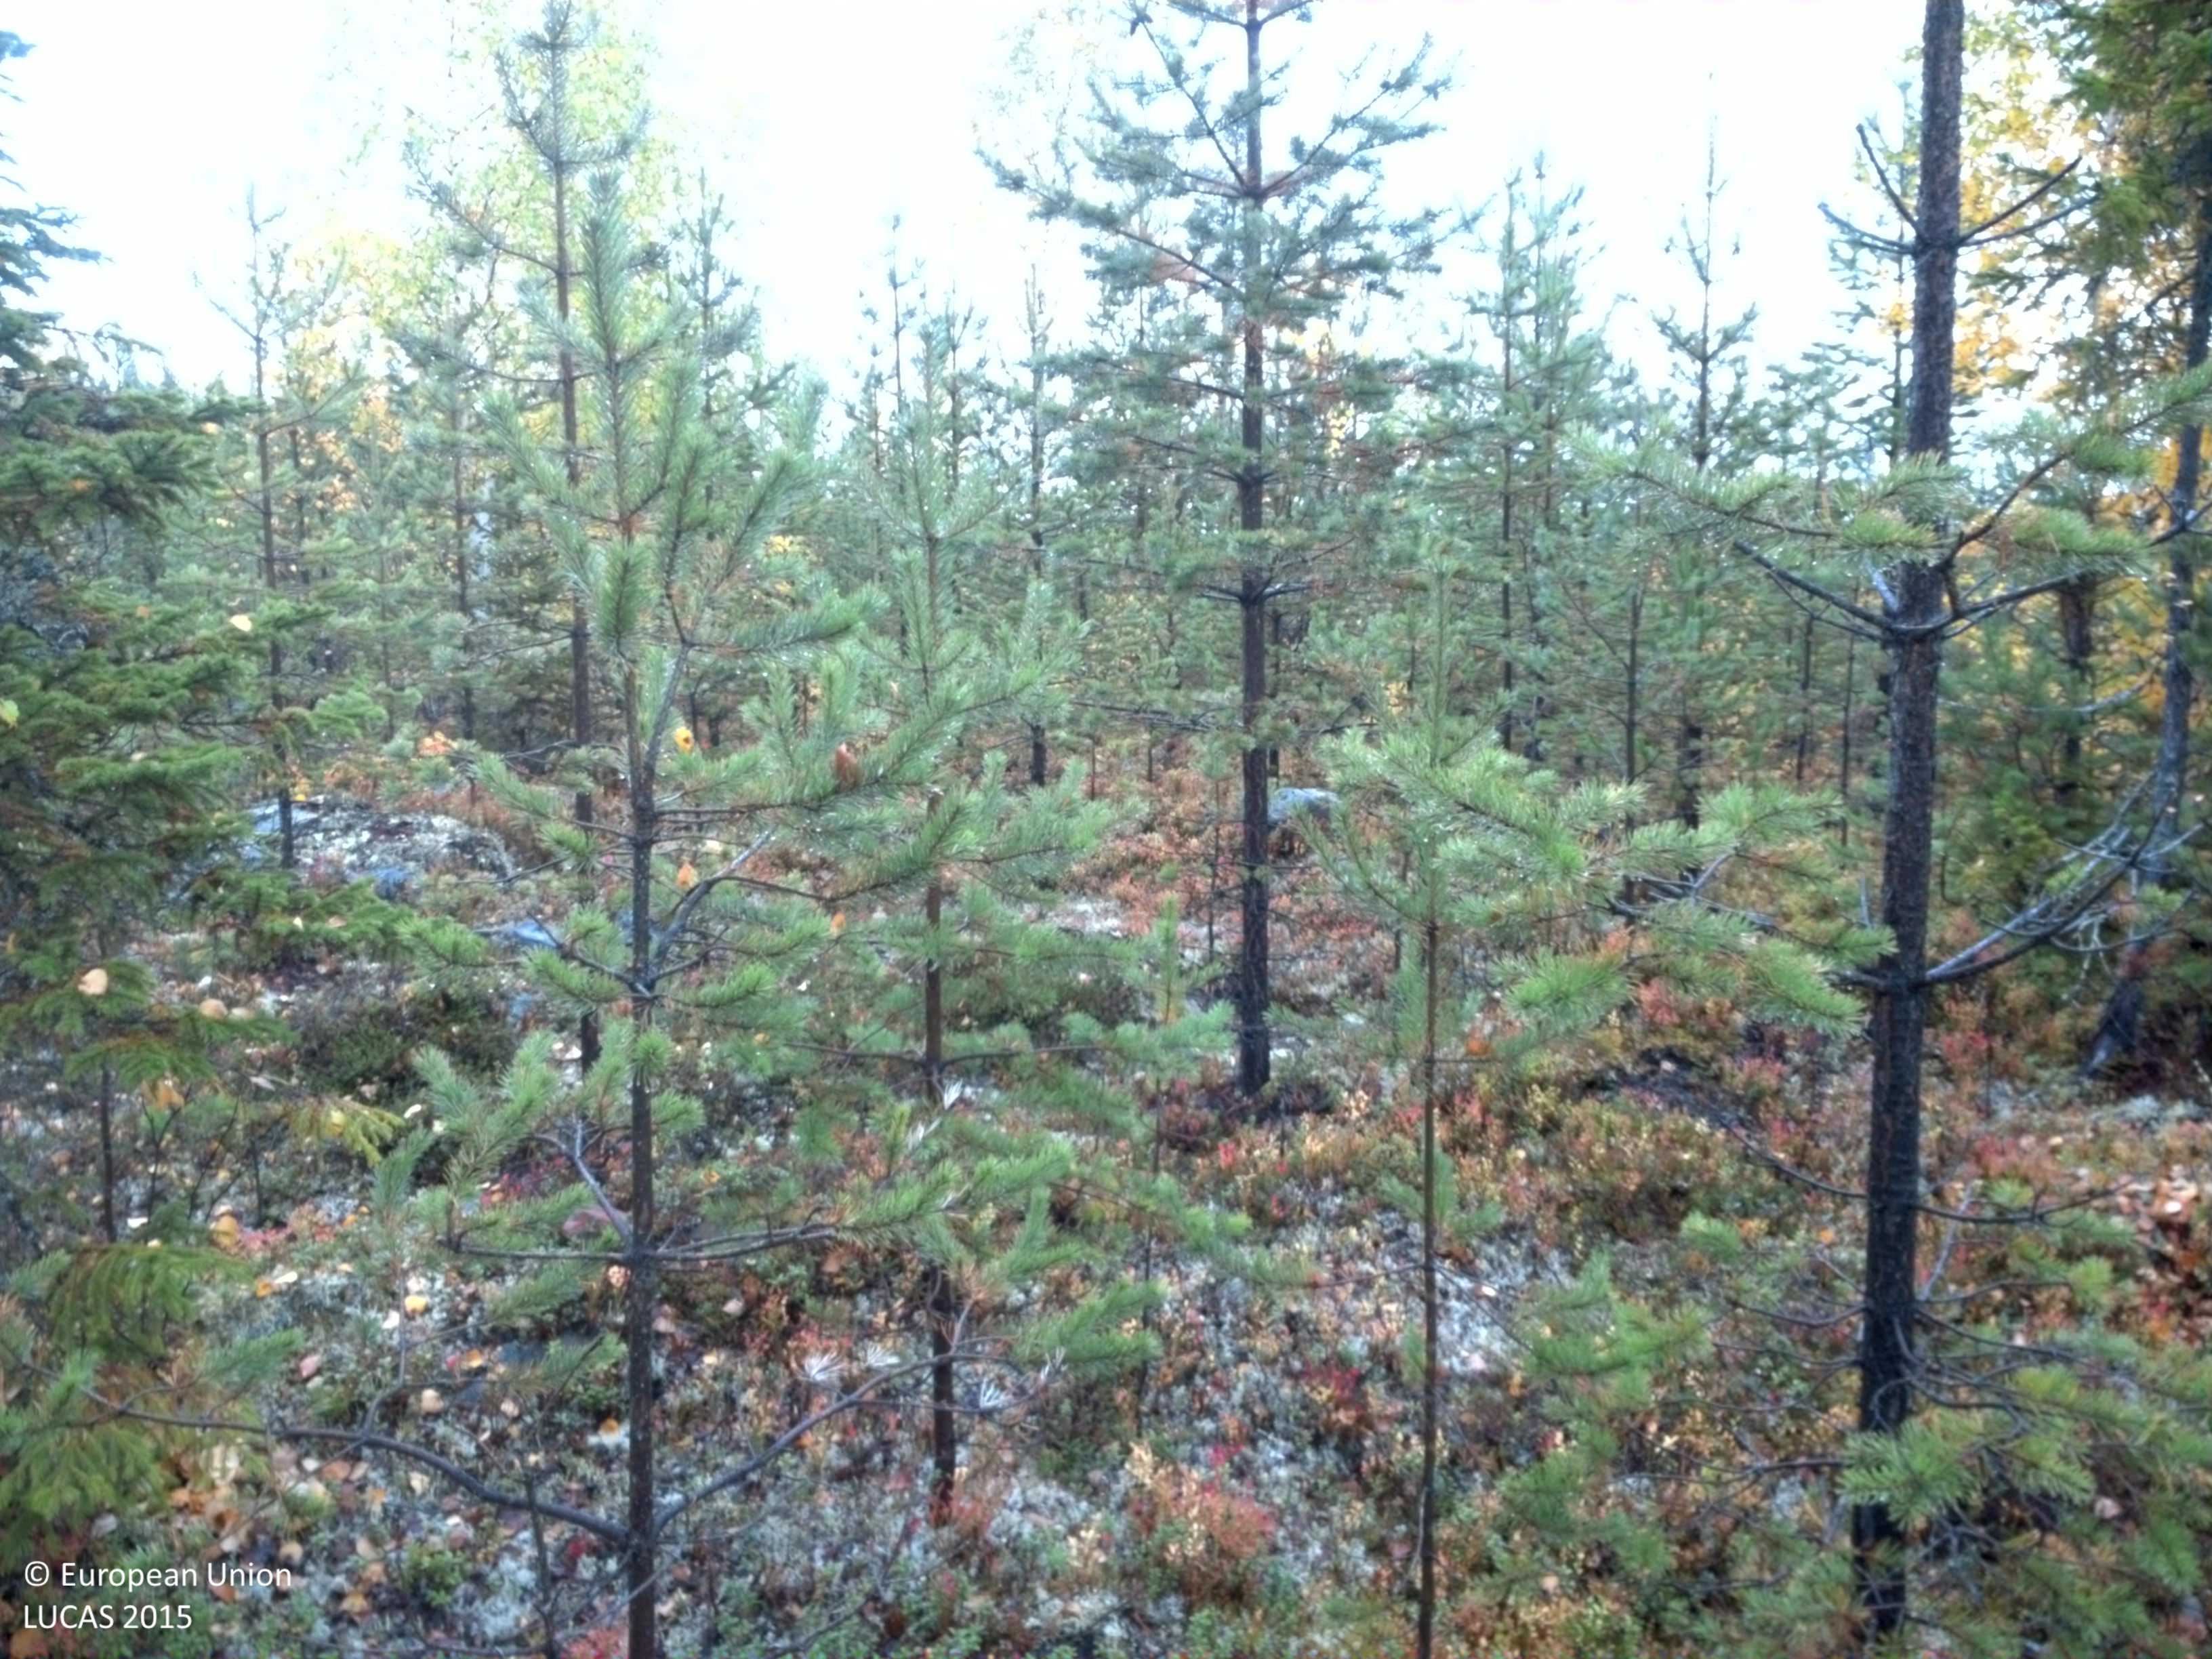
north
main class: Woodland
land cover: Pine dominated coniferous woodland
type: boreal forest
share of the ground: 25 - 50 %
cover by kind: shrubs 40 %, lichens and mosses 30 %, coniferous forest trees 20 %, broadleaved forest trees 5 %, unconsolidated bare surface 5 %
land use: Forestry
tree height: > 5 m
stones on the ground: < 10 %
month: September
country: SE
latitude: 65.0934
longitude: 17.4751
